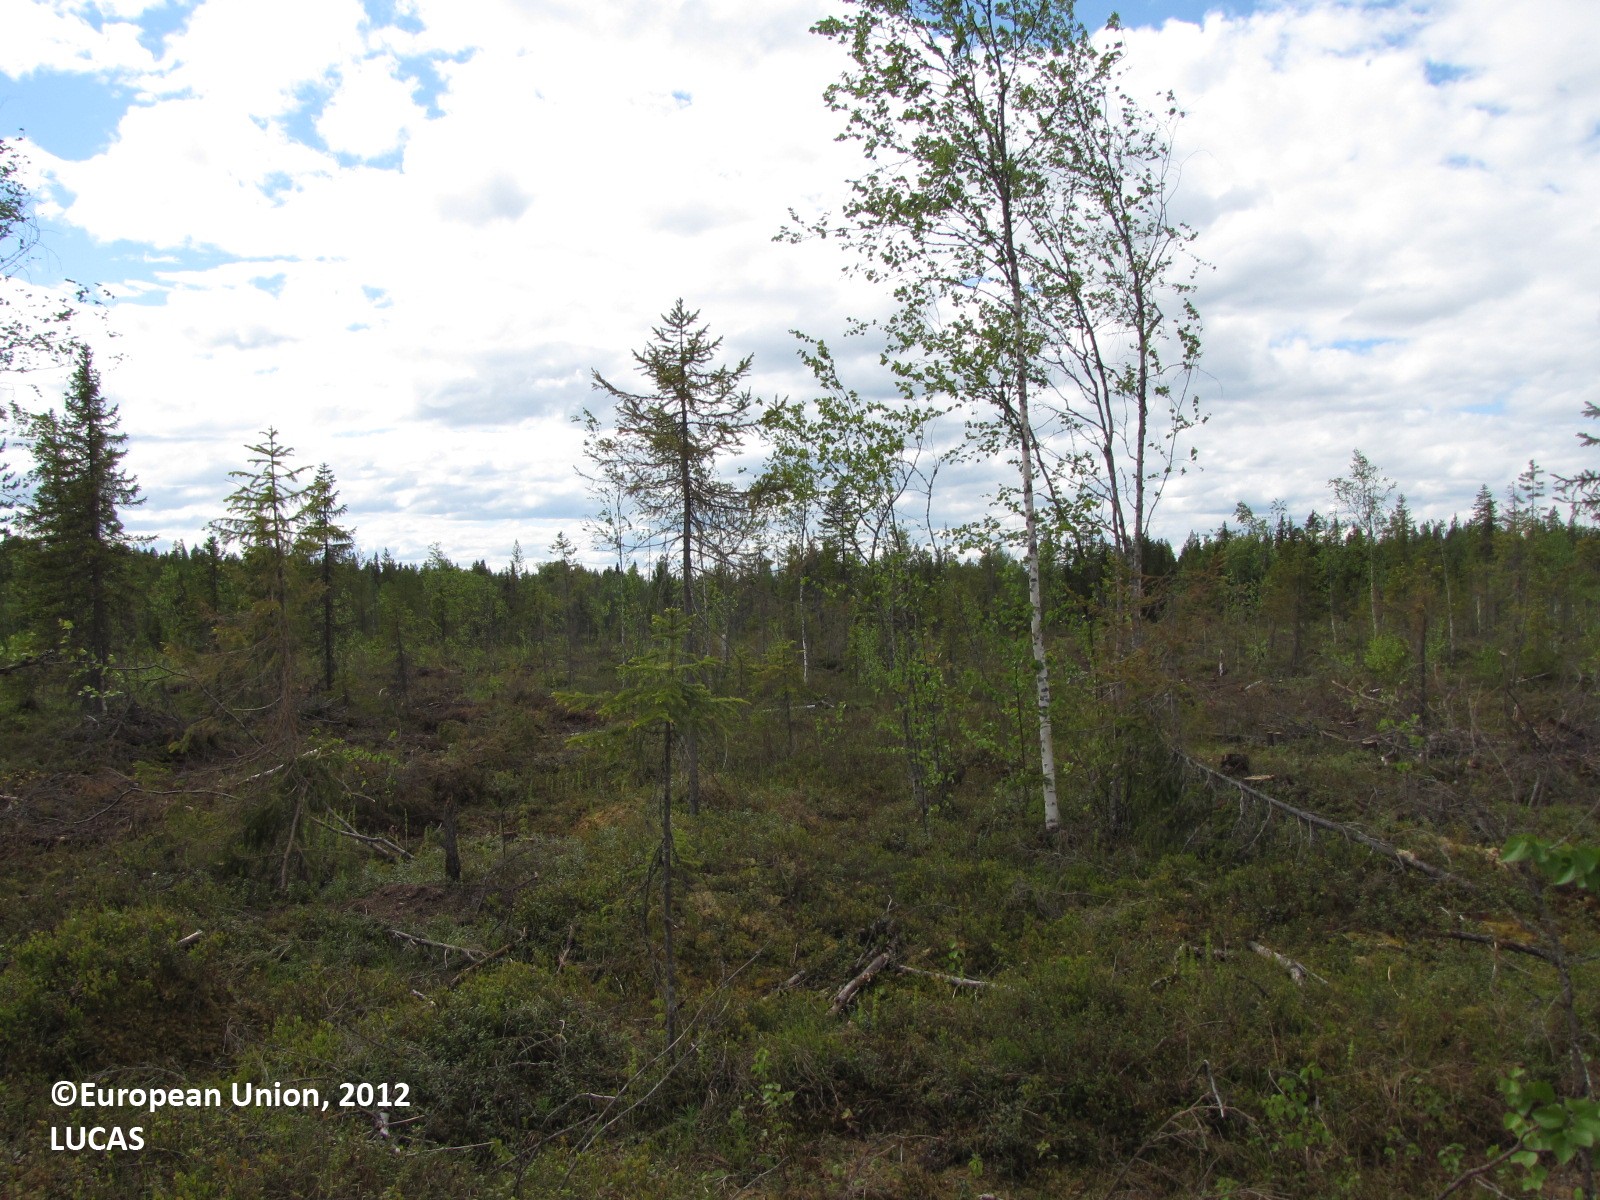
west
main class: Woodland
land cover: Other mixed woodland
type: boreal forest
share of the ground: 10 - 25 %
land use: Forestry
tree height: > 5 m
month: June
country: FI
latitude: 66.1069
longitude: 25.1294
